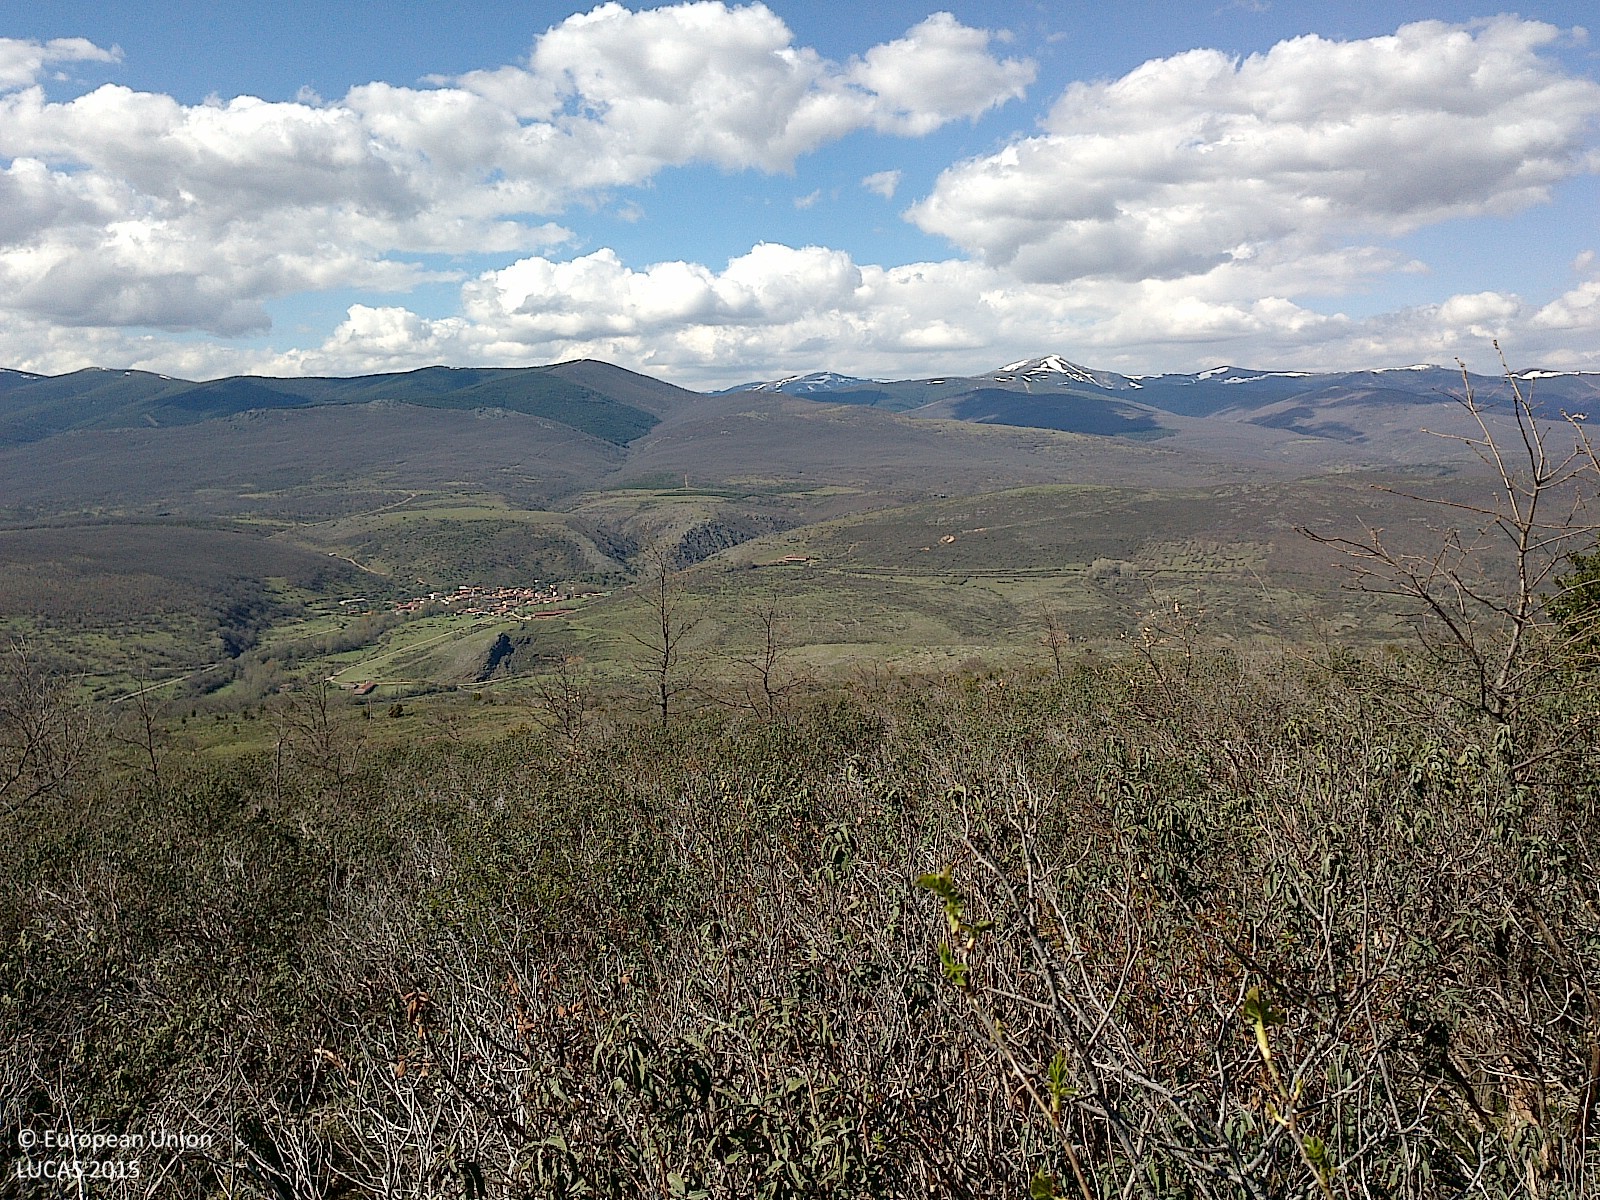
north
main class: Shrubland
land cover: Shrubland with sparse tree cover
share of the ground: > 75 %
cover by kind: shrubs 80 %, herbaceous plants 15 %, broadleaved forest trees 5 %
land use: Agriculture (excluding fallow land and kitchen gardens)
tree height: < 5 m
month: April
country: ES
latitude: 42.0943
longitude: -3.2176
